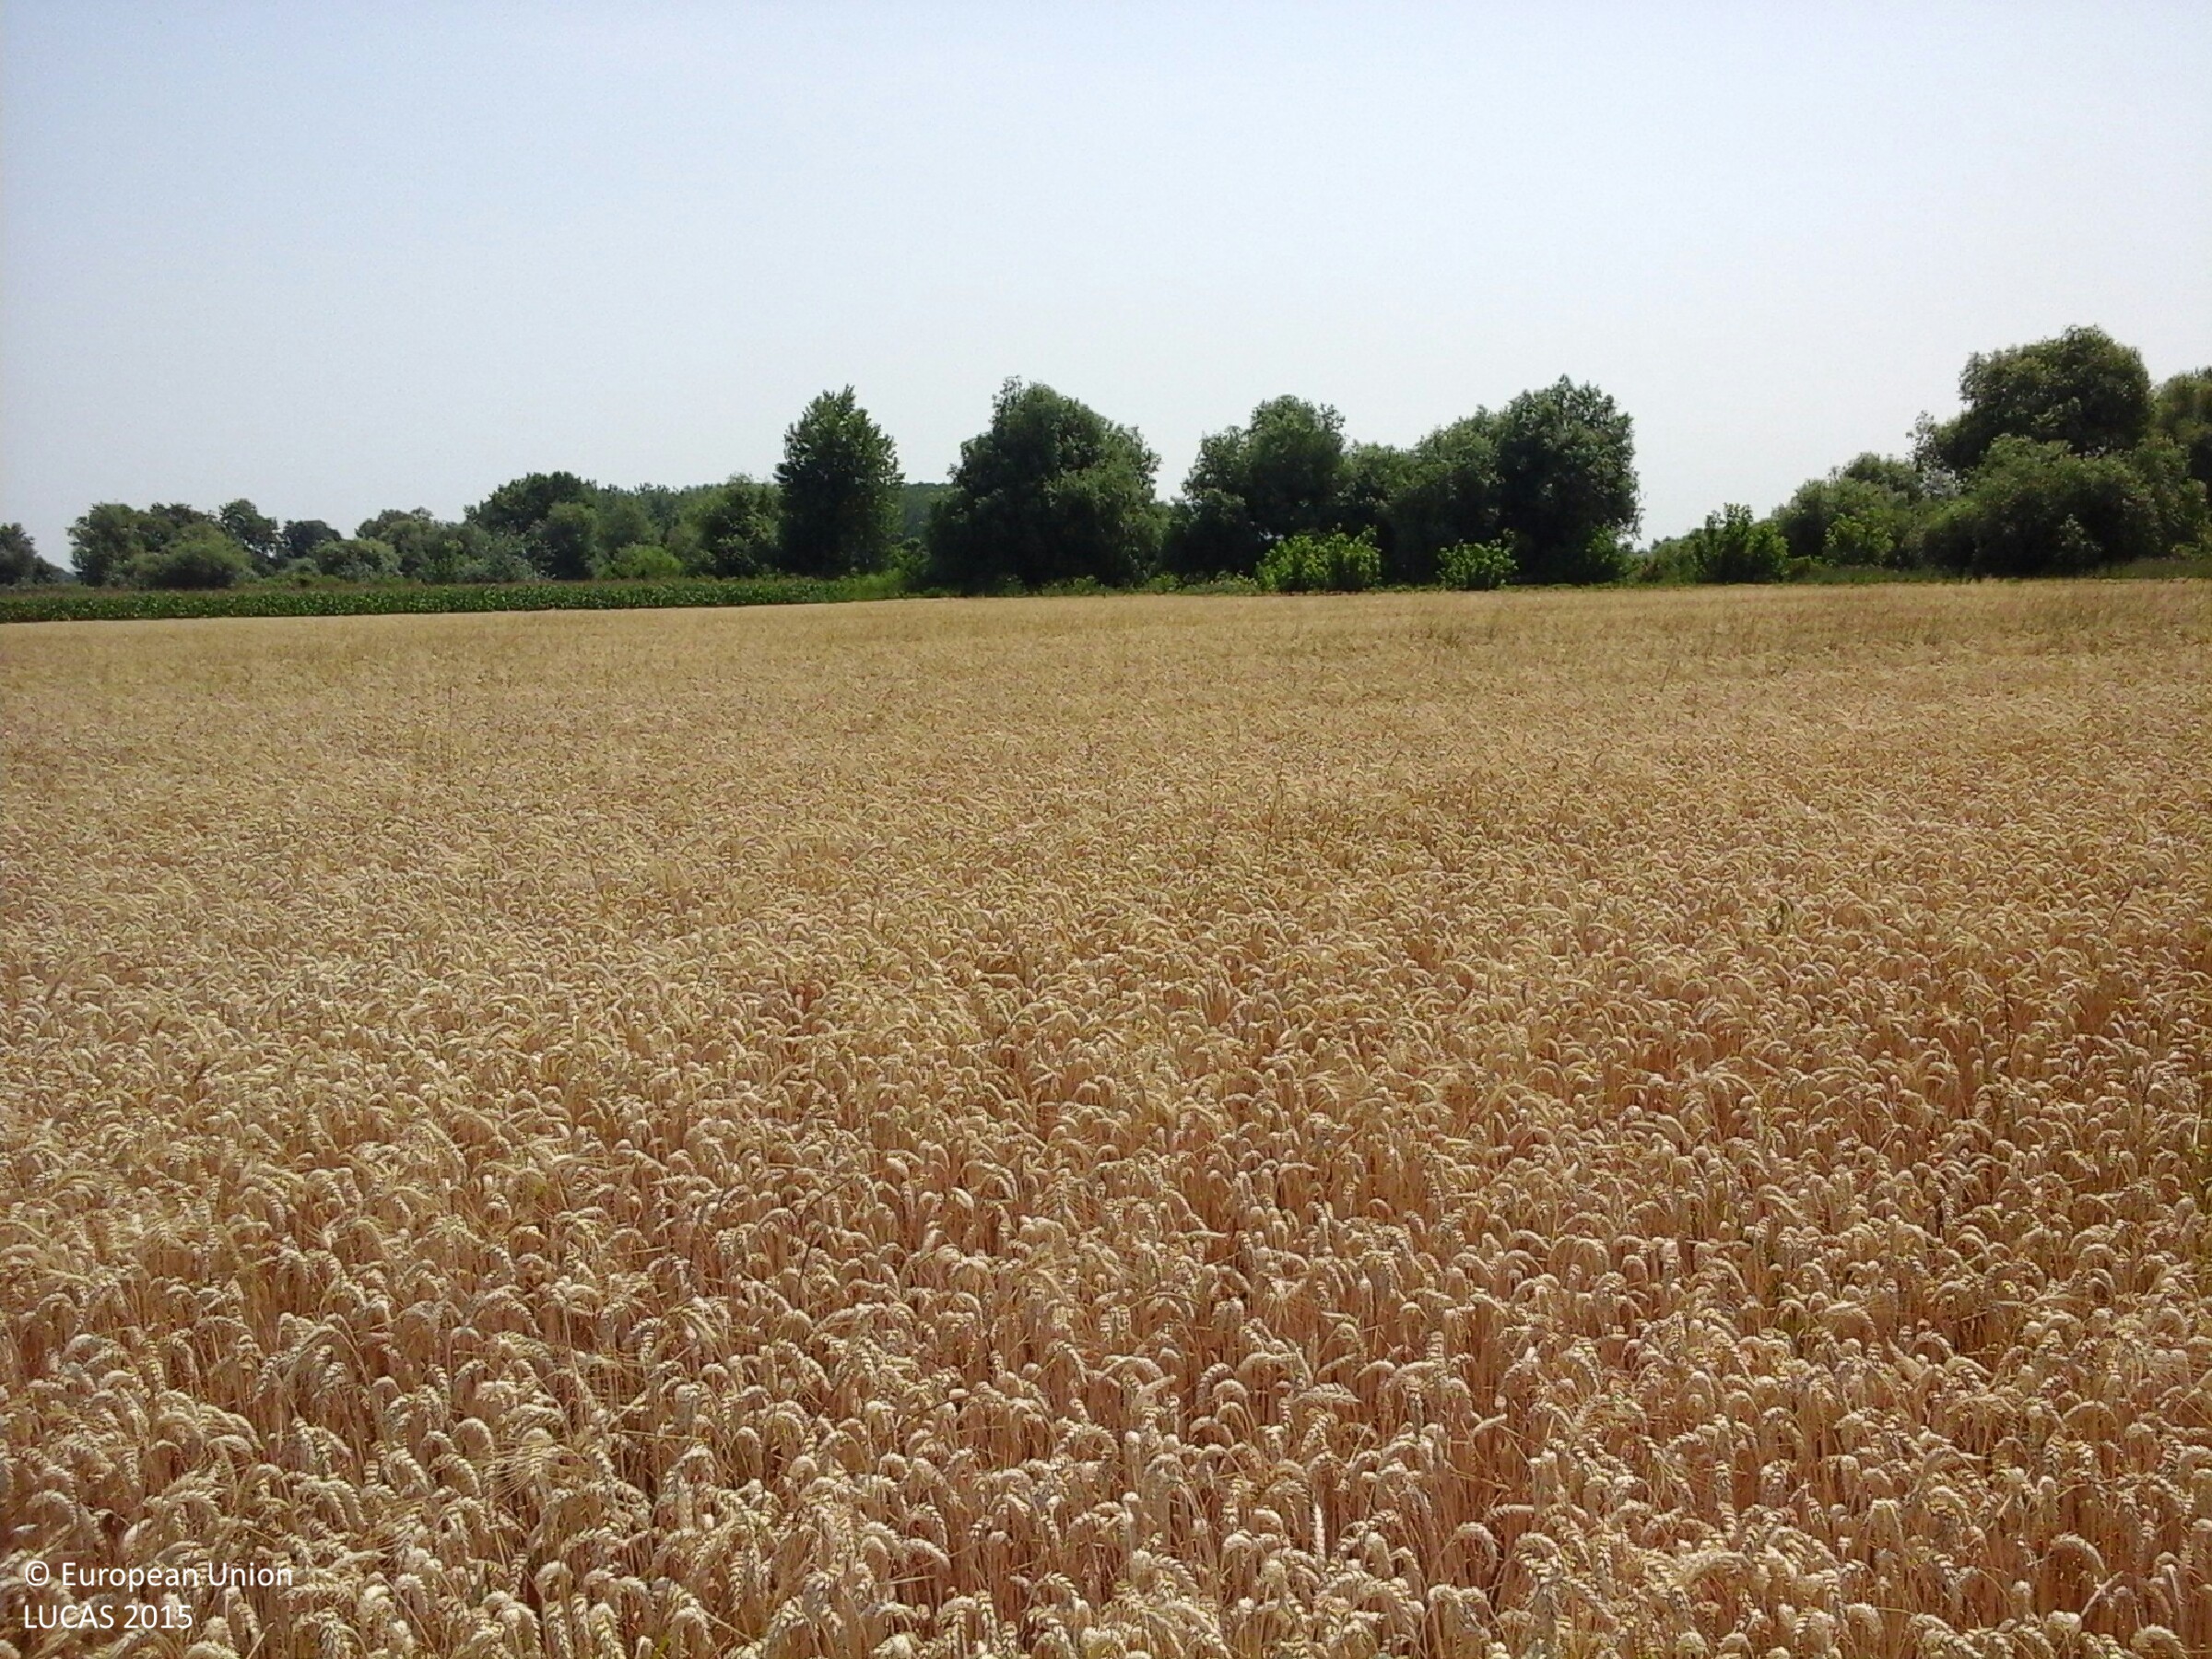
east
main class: Cropland
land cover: Common wheat
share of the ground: > 75 %
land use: Agriculture (excluding fallow land and kitchen gardens)
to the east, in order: Common wheat; Maize; Shrubland with sparse tree cover
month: July
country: HU
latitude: 47.9611
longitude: 21.0072
